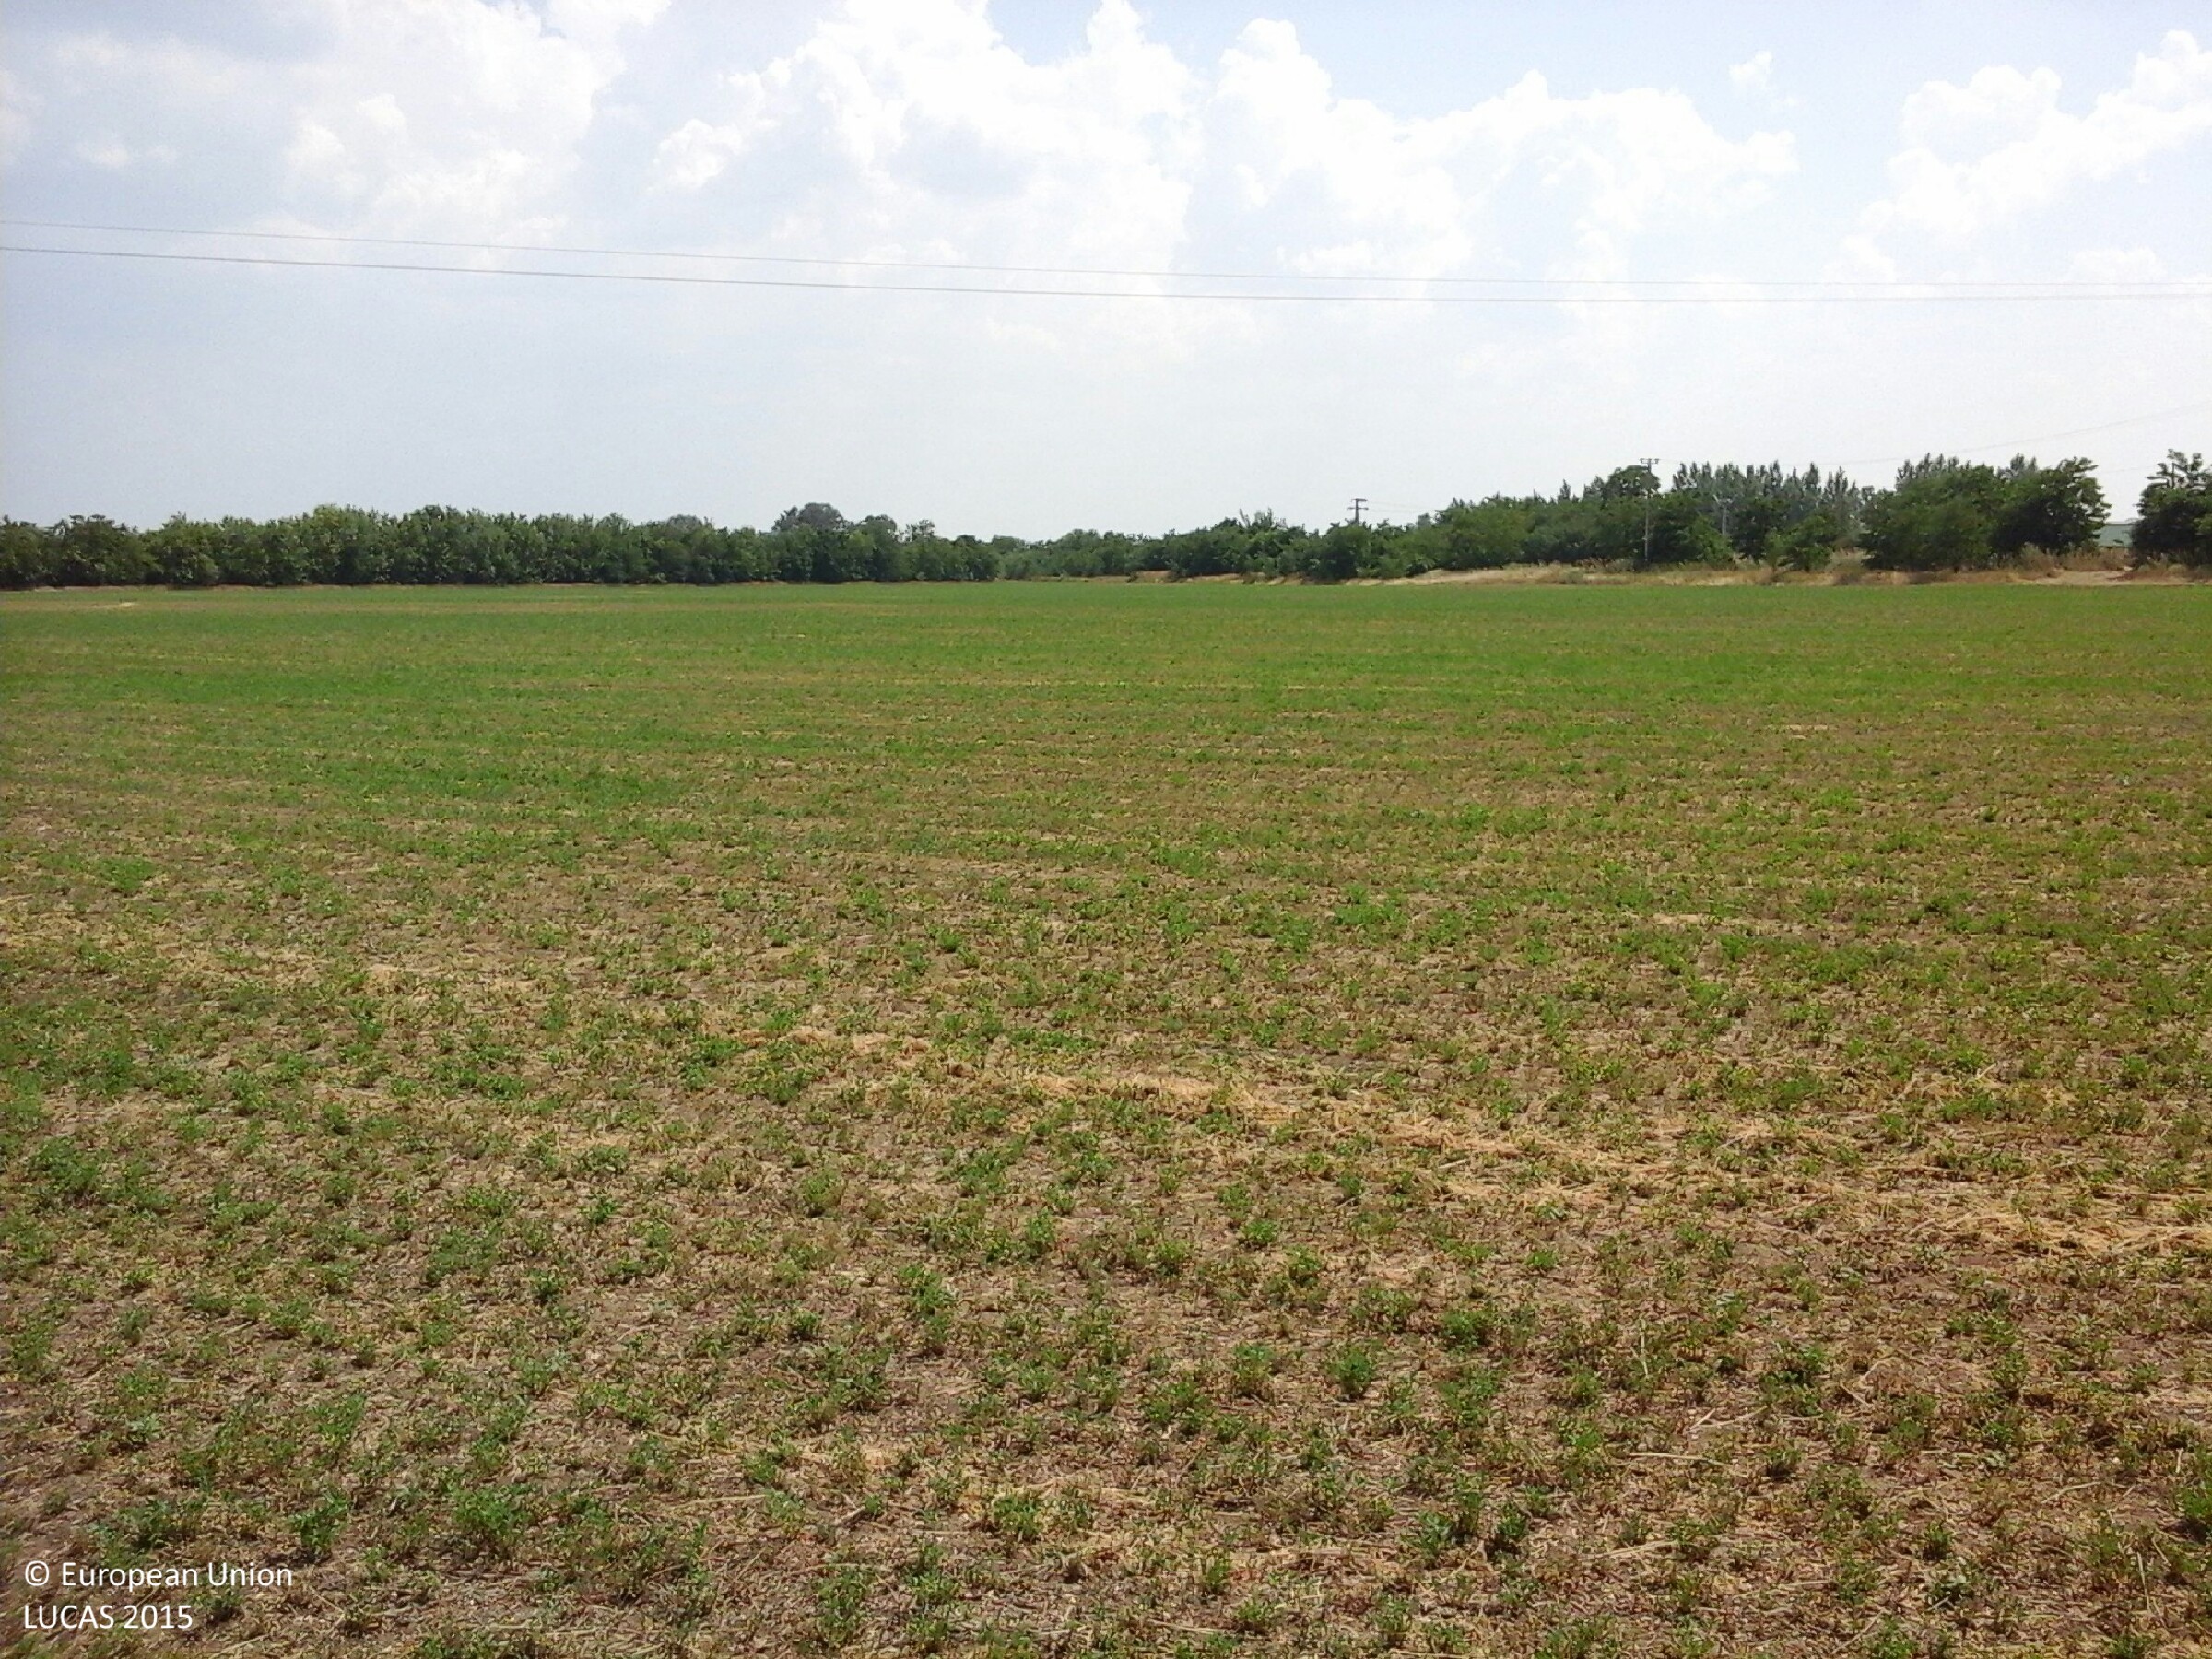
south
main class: Cropland
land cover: Lucerne
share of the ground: 50 - 75 %
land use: Agriculture (excluding fallow land and kitchen gardens)
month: July
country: HU
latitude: 47.8012
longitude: 20.9725
